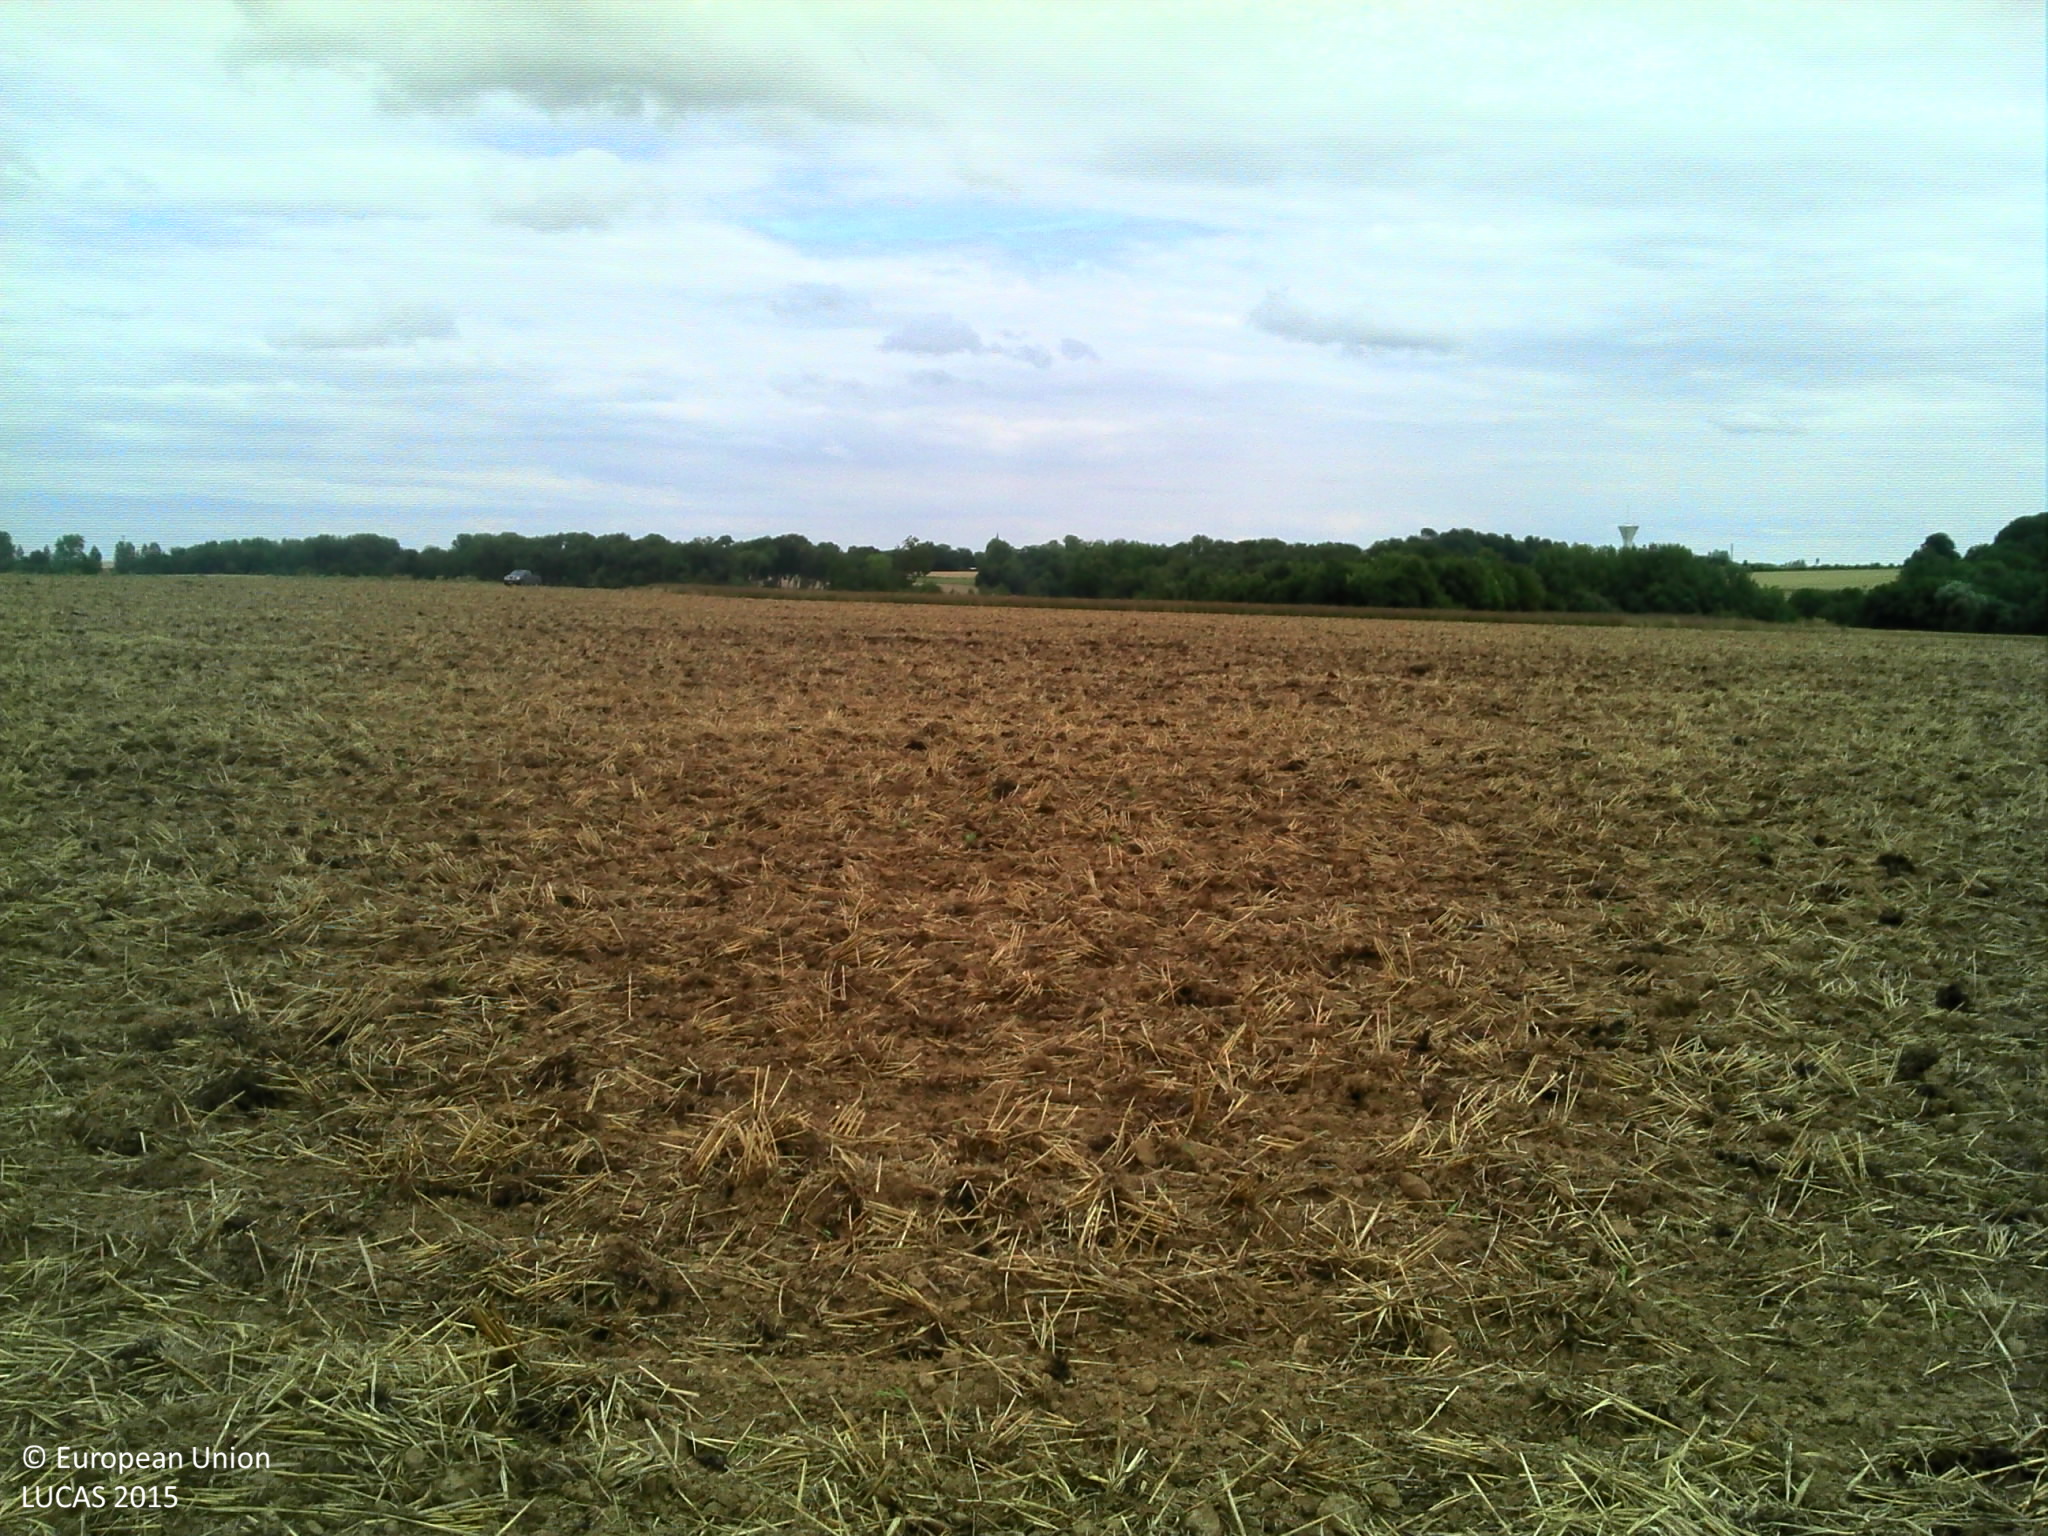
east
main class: Cropland
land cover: Barley
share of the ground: 10 - 25 %
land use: Agriculture (excluding fallow land and kitchen gardens)
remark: Harvested field
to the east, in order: Barley; Rape and turnip rape
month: July
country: FR
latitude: 50.1293
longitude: 2.1376
